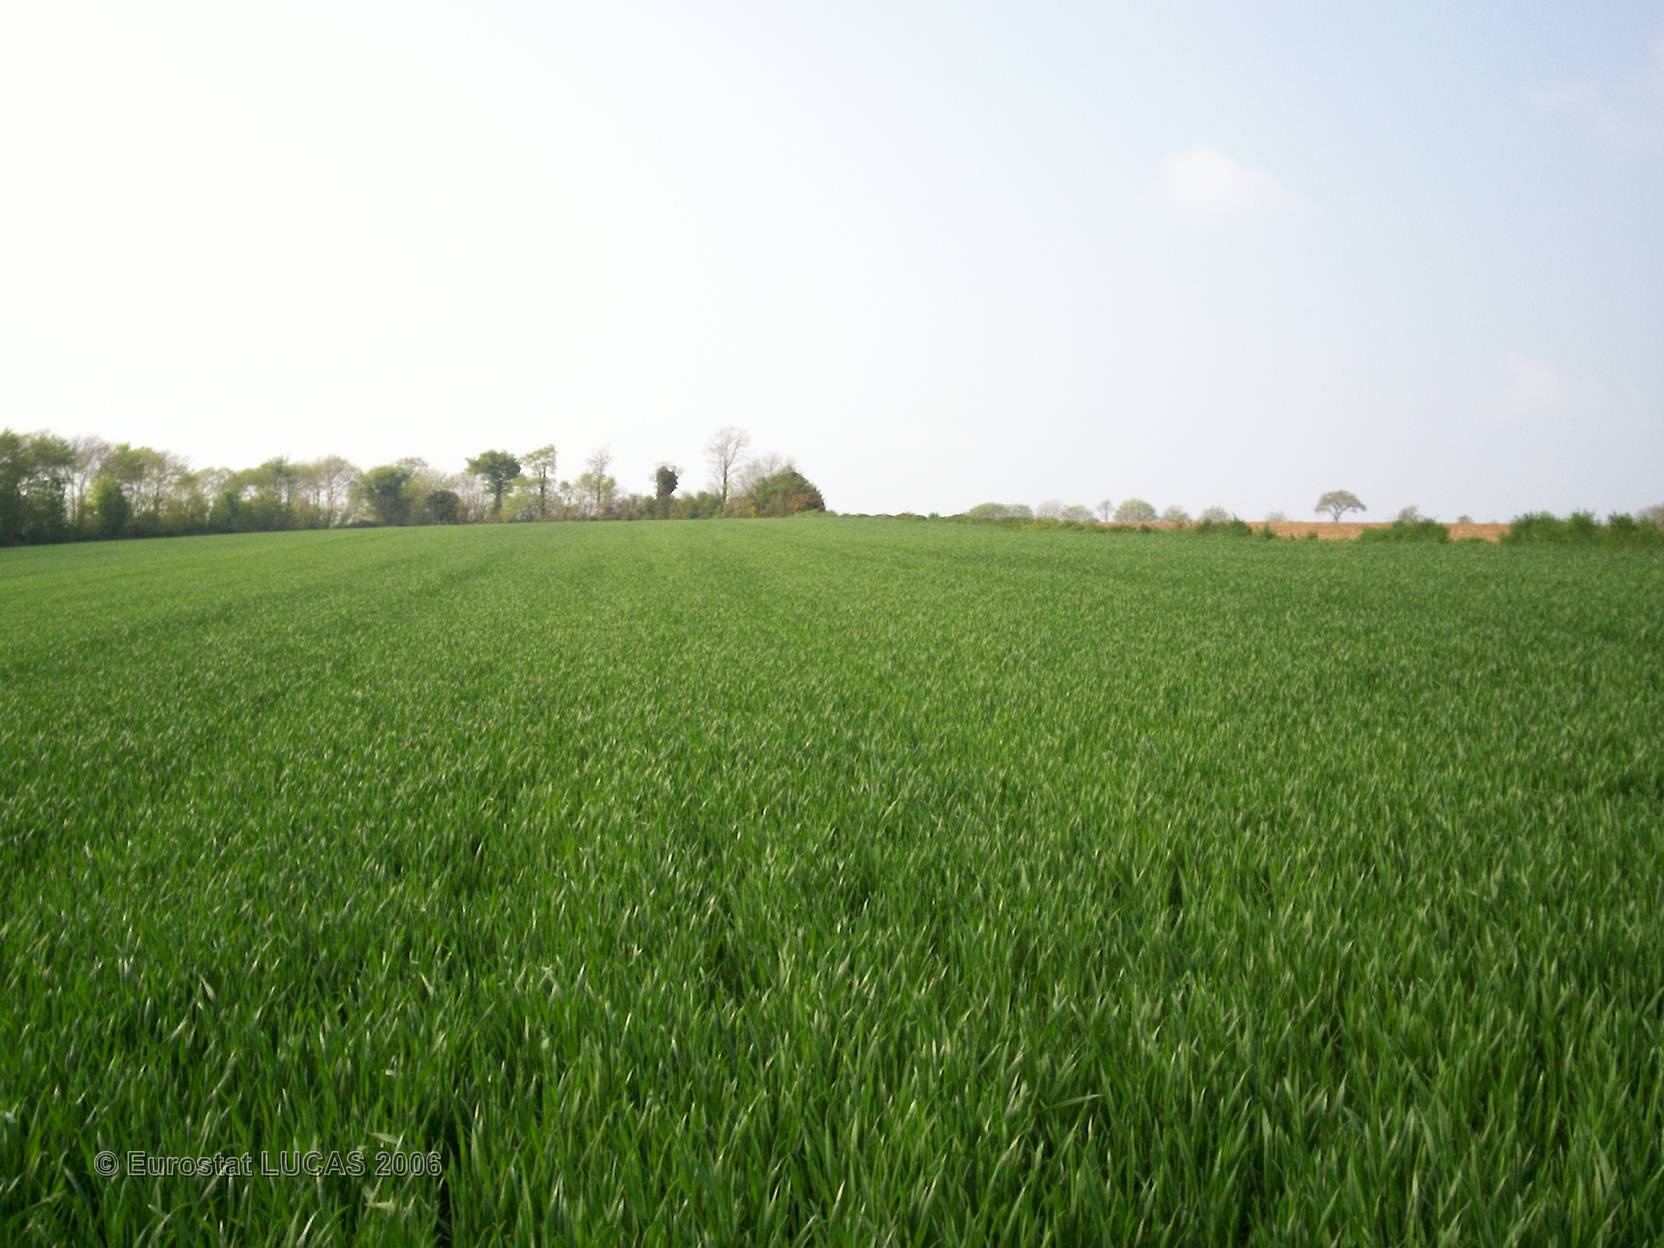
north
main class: Cropland
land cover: Common wheat
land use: Agriculture (excluding fallow land and kitchen gardens)
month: May
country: FR
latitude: 48.2415
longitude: -3.9697
